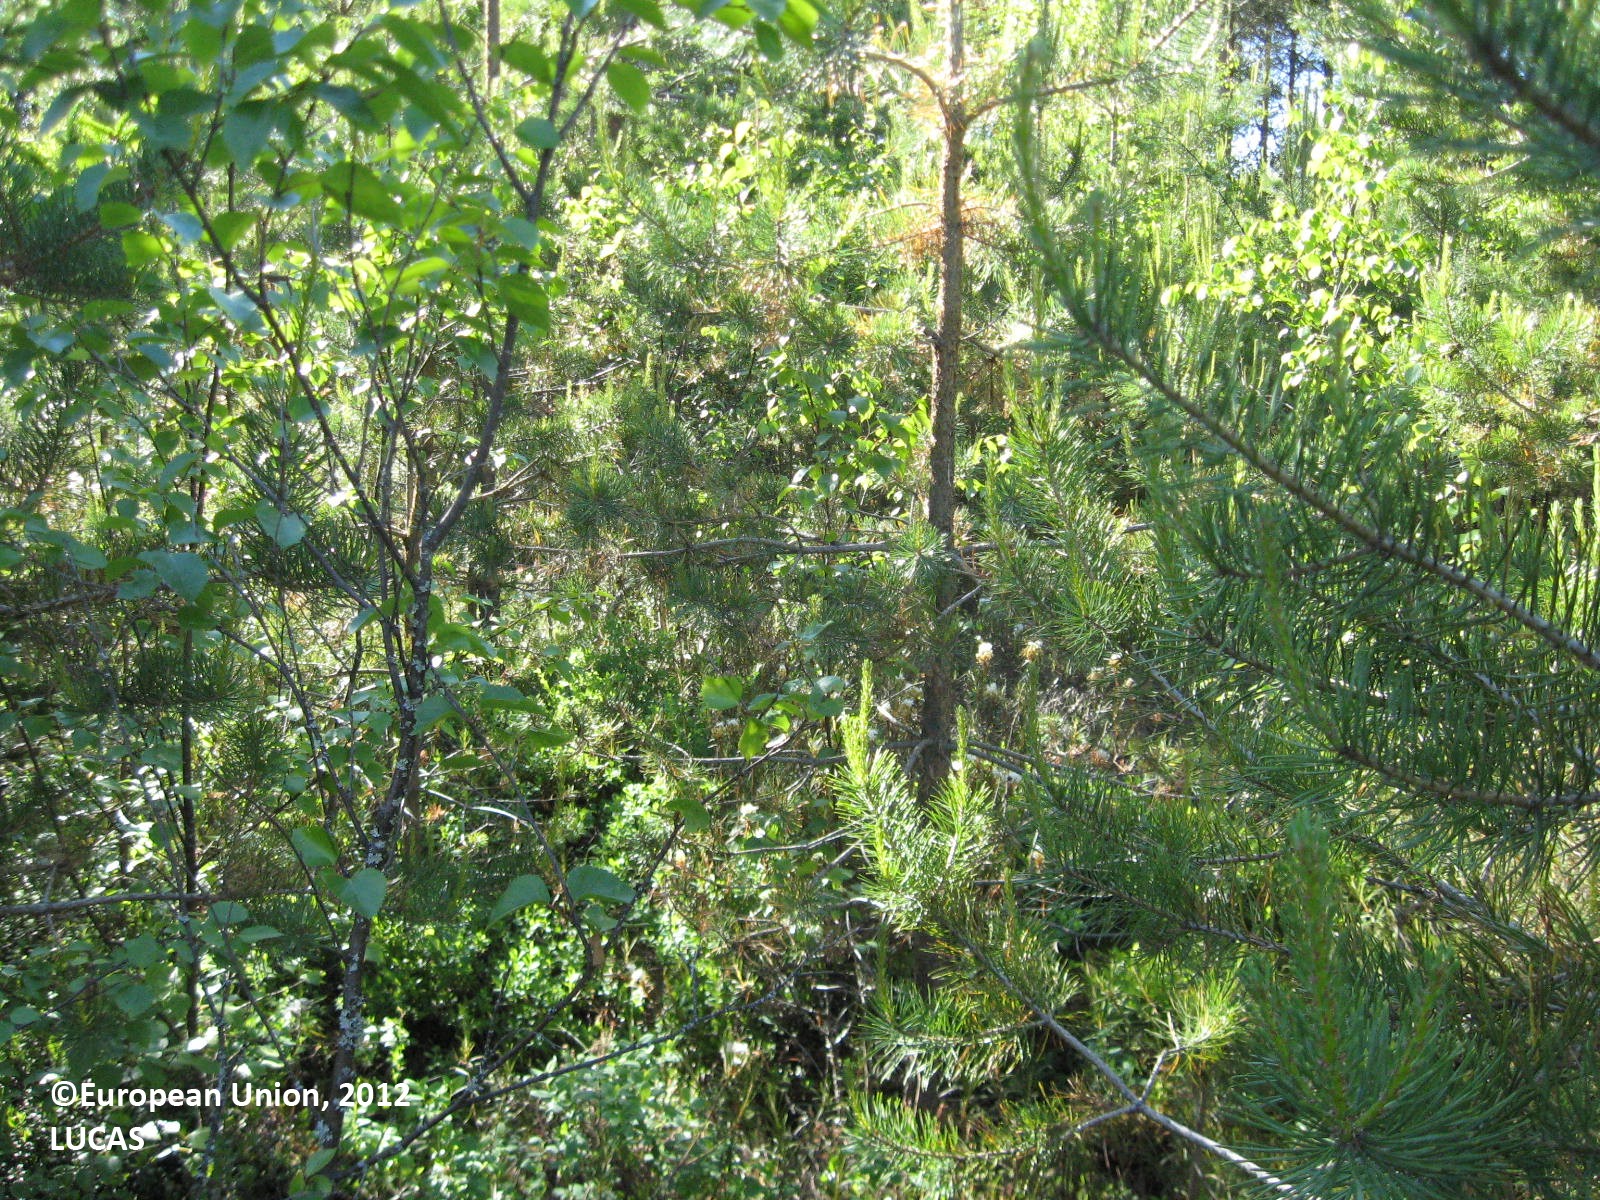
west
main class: Woodland
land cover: Pine dominated coniferous woodland
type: boreal forest
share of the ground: > 75 %
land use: Forestry
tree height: < 5 m
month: June
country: FI
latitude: 62.7638
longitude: 21.6178
